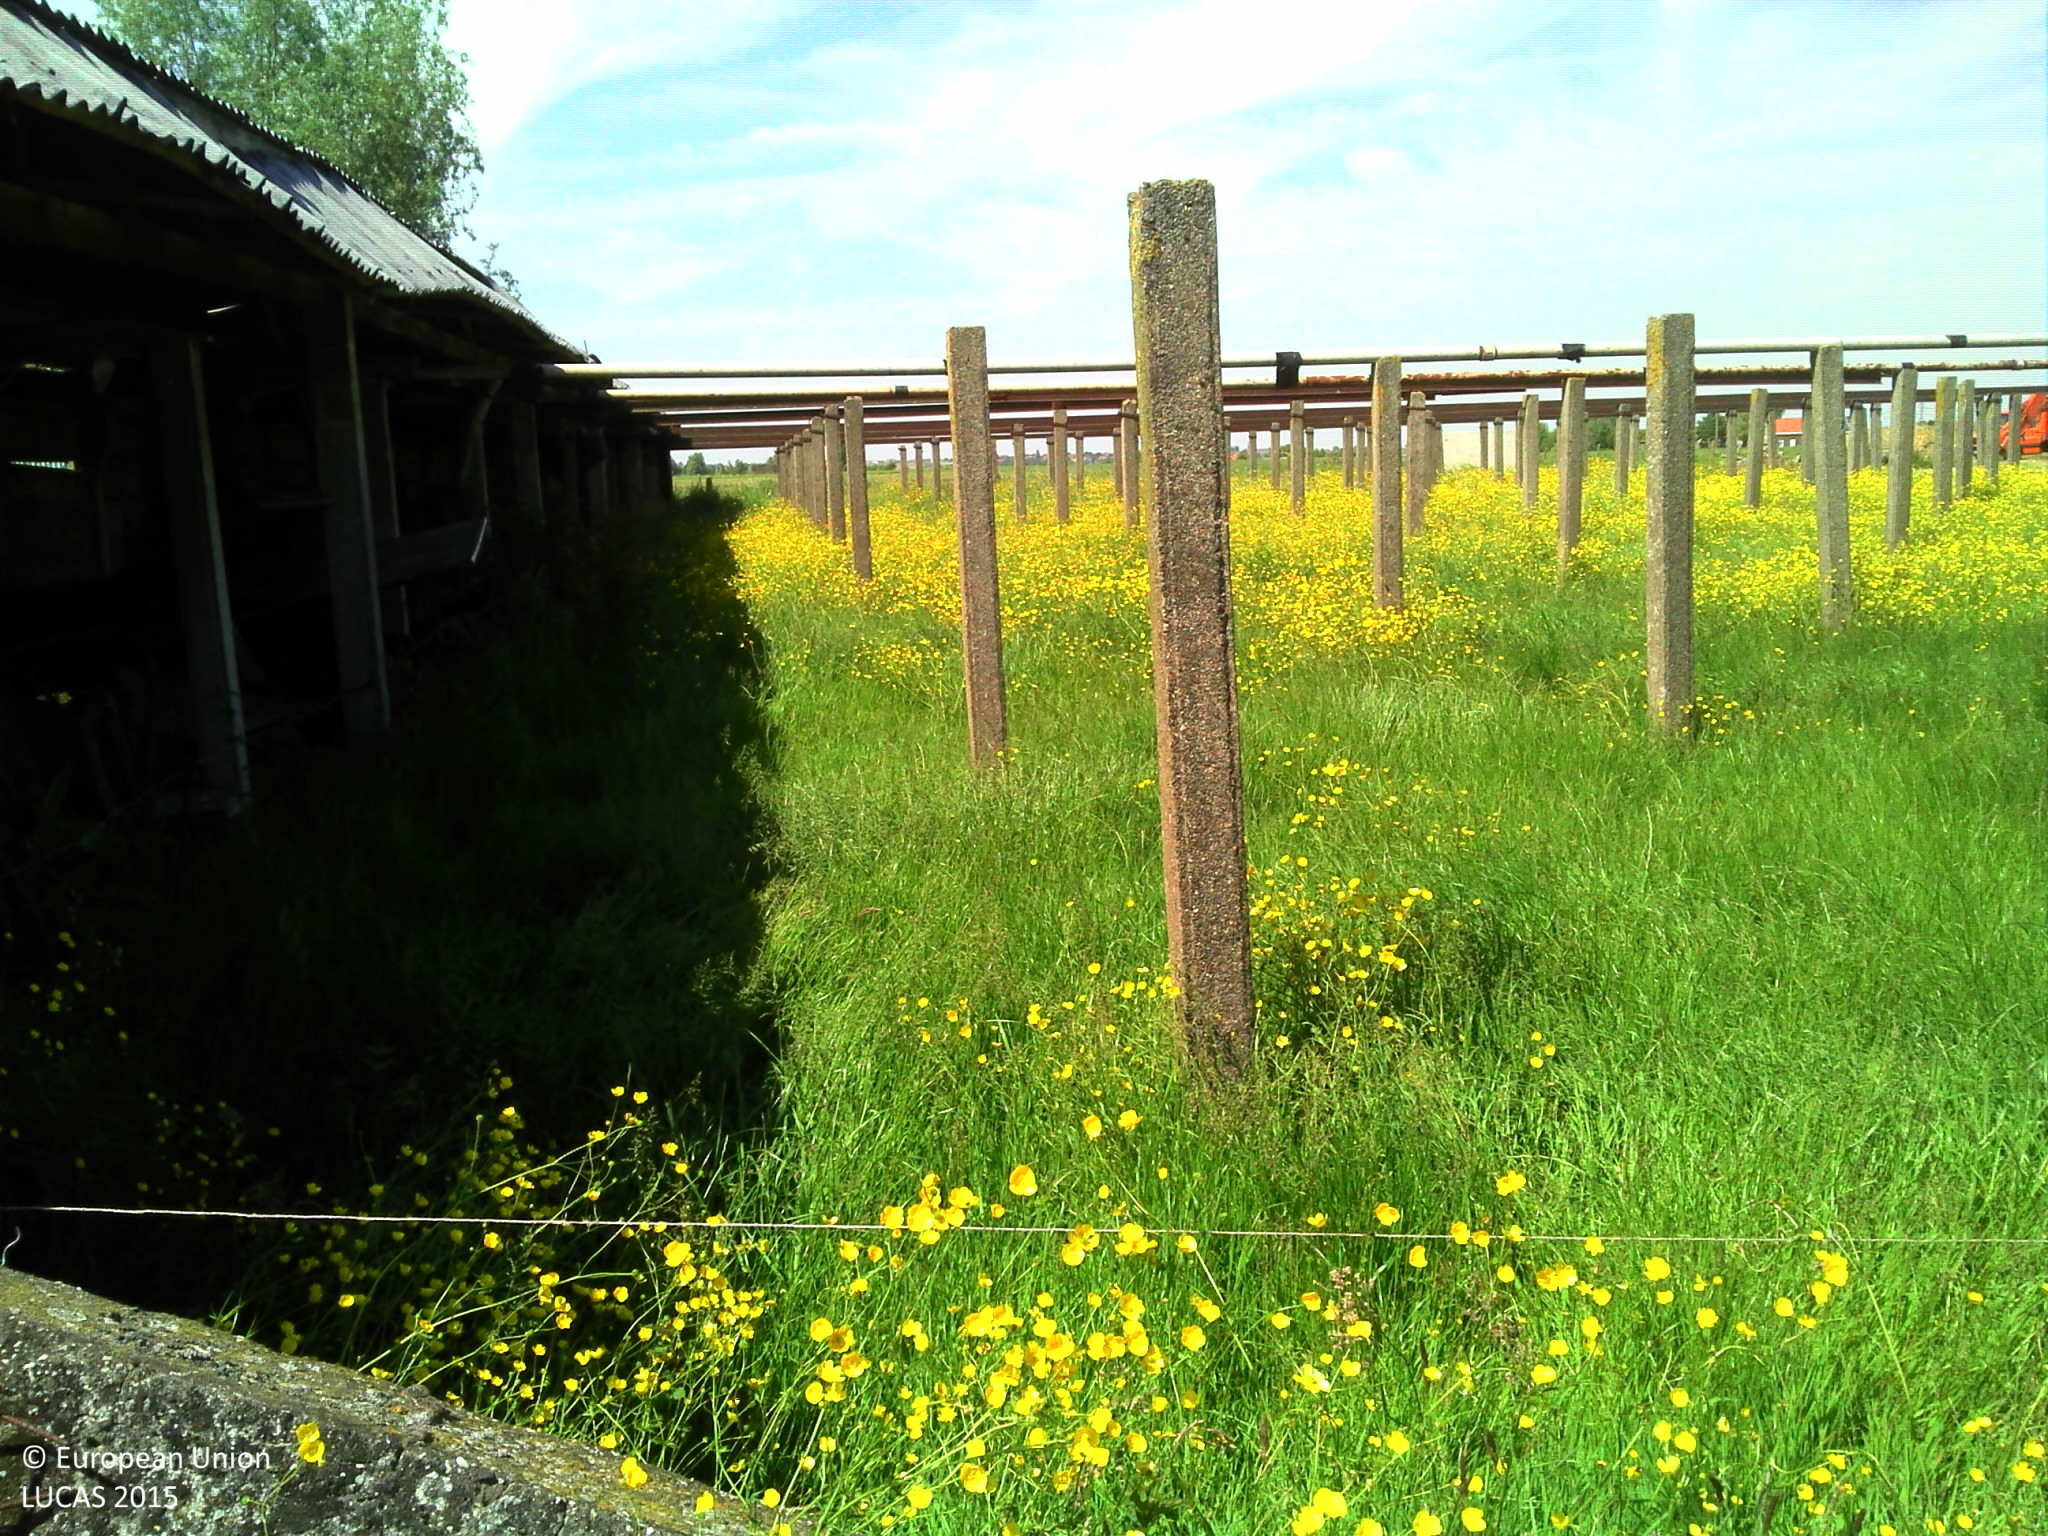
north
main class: Grassland
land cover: Grassland without tree/shrub cover
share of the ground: > 75 %
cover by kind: herbaceous plants 100 %
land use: Semi-natural and natural areas not in use
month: June
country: BE
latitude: 50.8186
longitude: 3.0206
